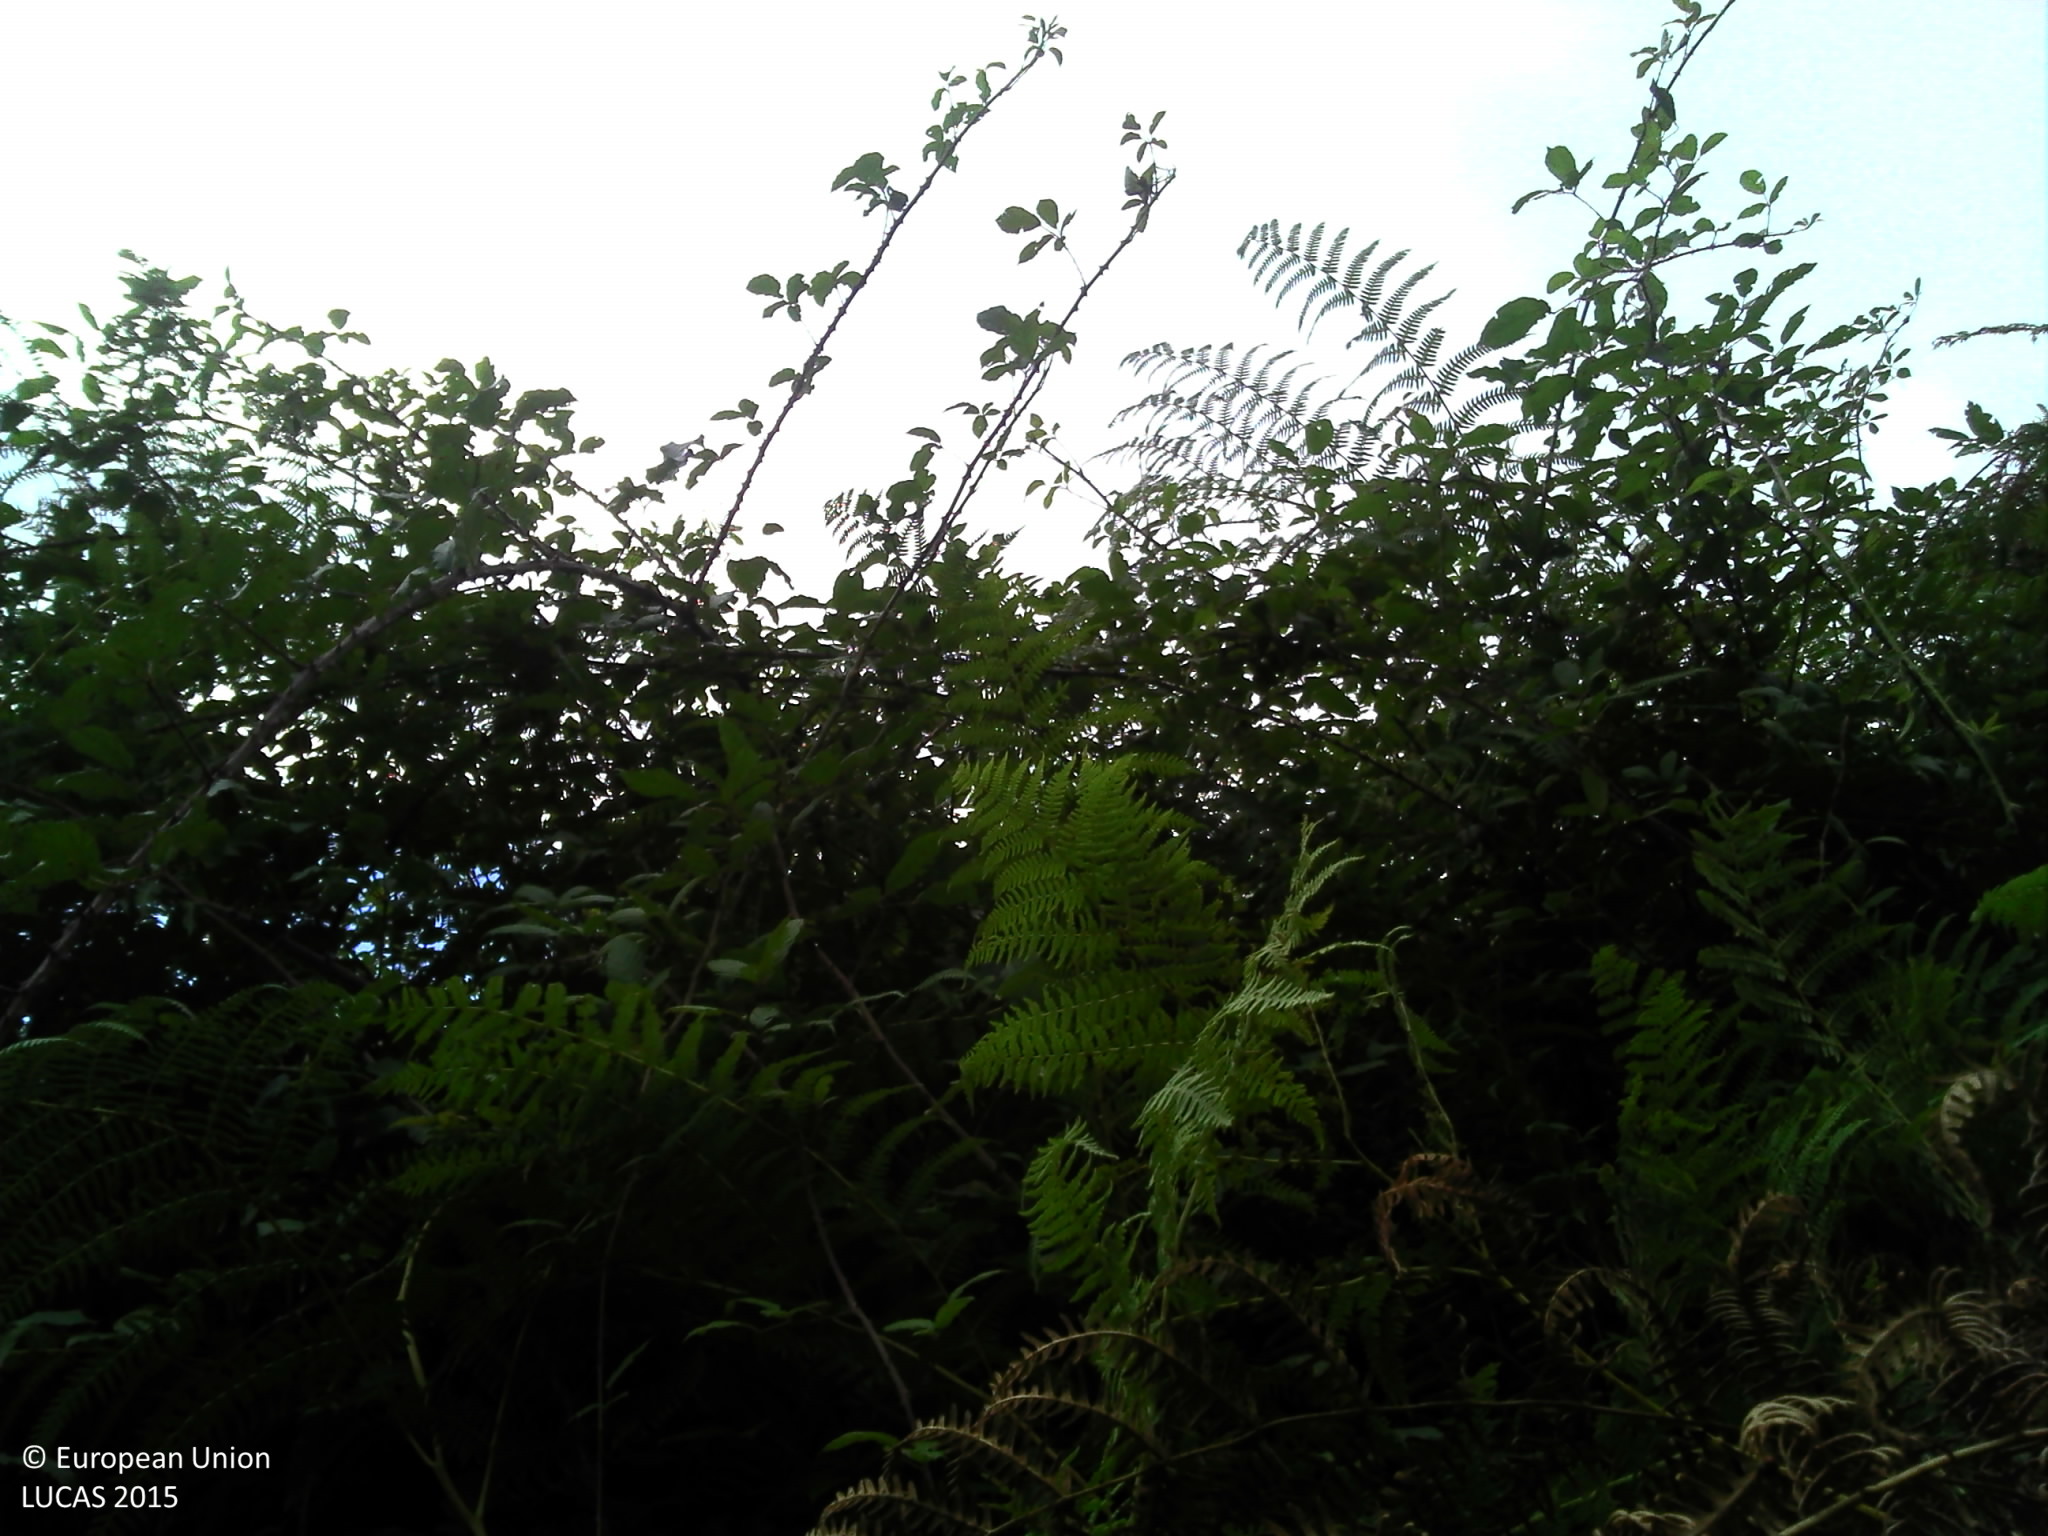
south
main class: Shrubland
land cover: Shrubland without tree cover
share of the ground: > 75 %
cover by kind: shrubs 50 %, herbaceous plants 50 %
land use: Abandoned areas
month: September
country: FR
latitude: 43.3381
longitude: -0.7288
